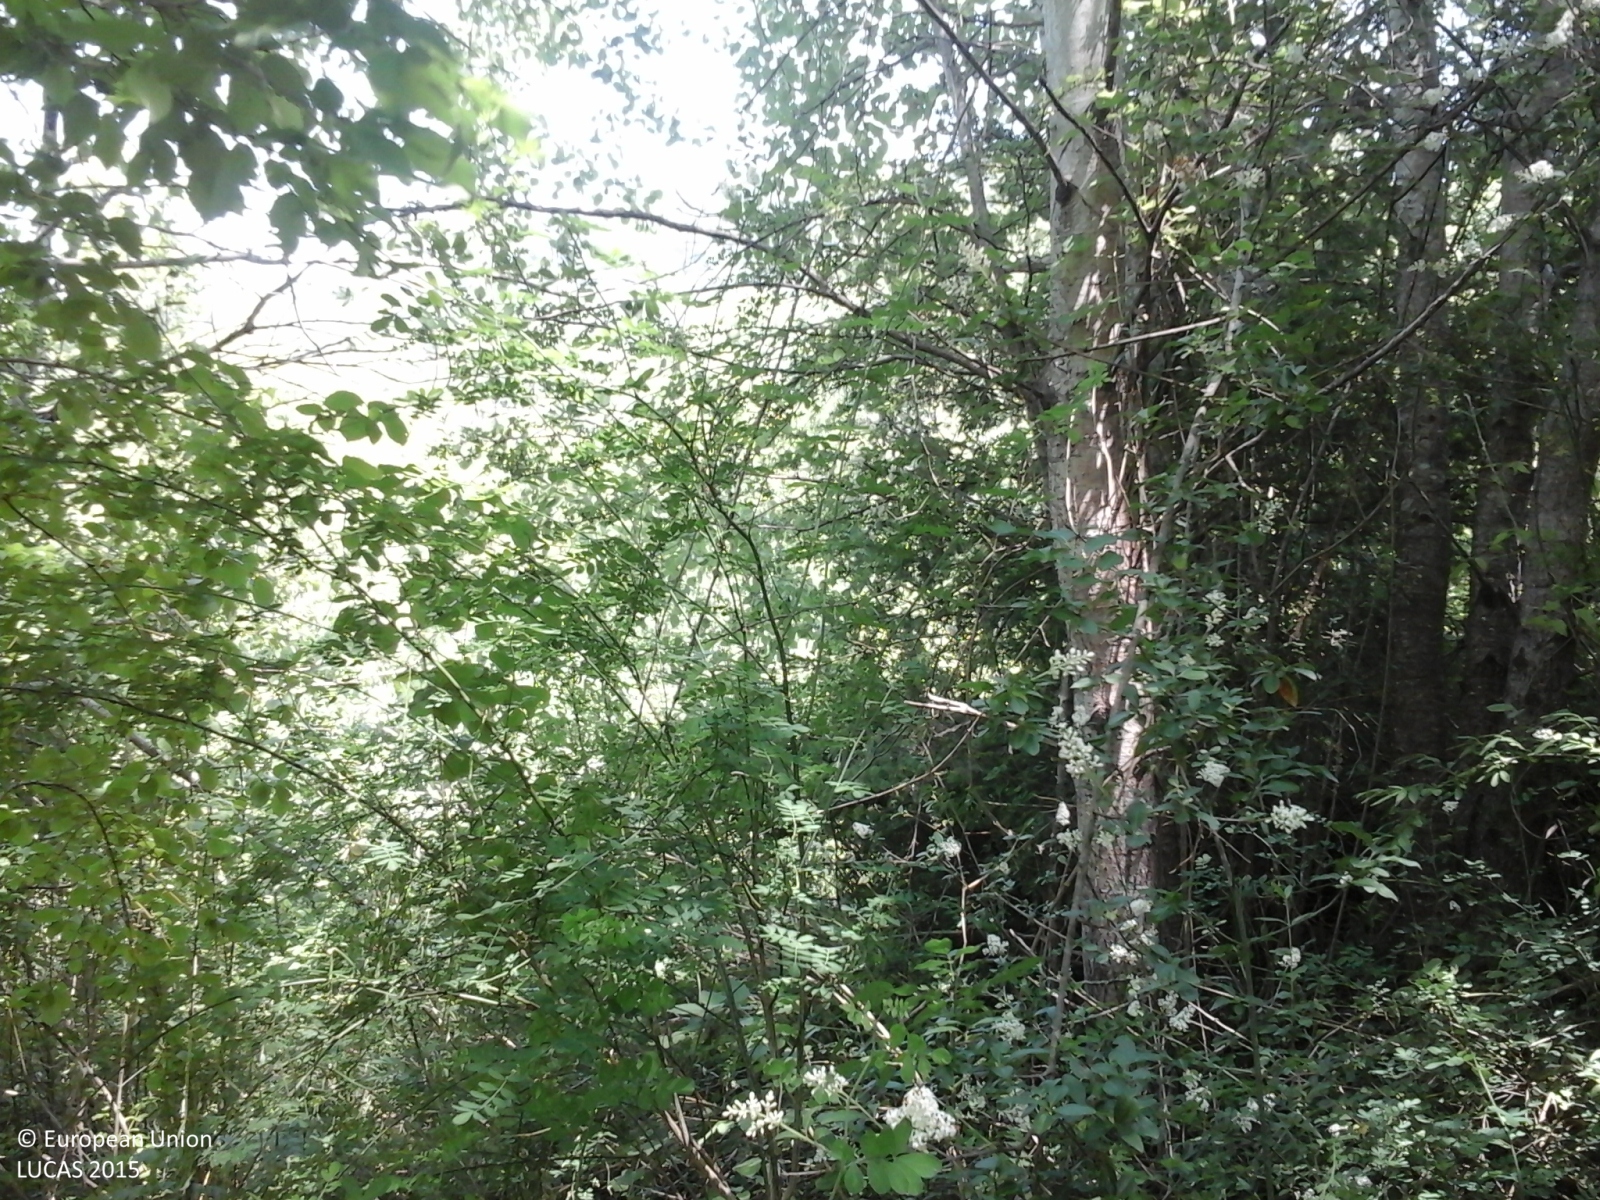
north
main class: Woodland
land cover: Broadleaved woodland
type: thermophilous deciduous forest
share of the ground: > 75 %
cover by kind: broadleaved forest trees 80 %, shrubs 10 %, herbaceous plants 10 %
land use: Abandoned areas
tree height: > 5 m
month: June
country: IT
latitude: 41.9120
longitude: 14.2898
